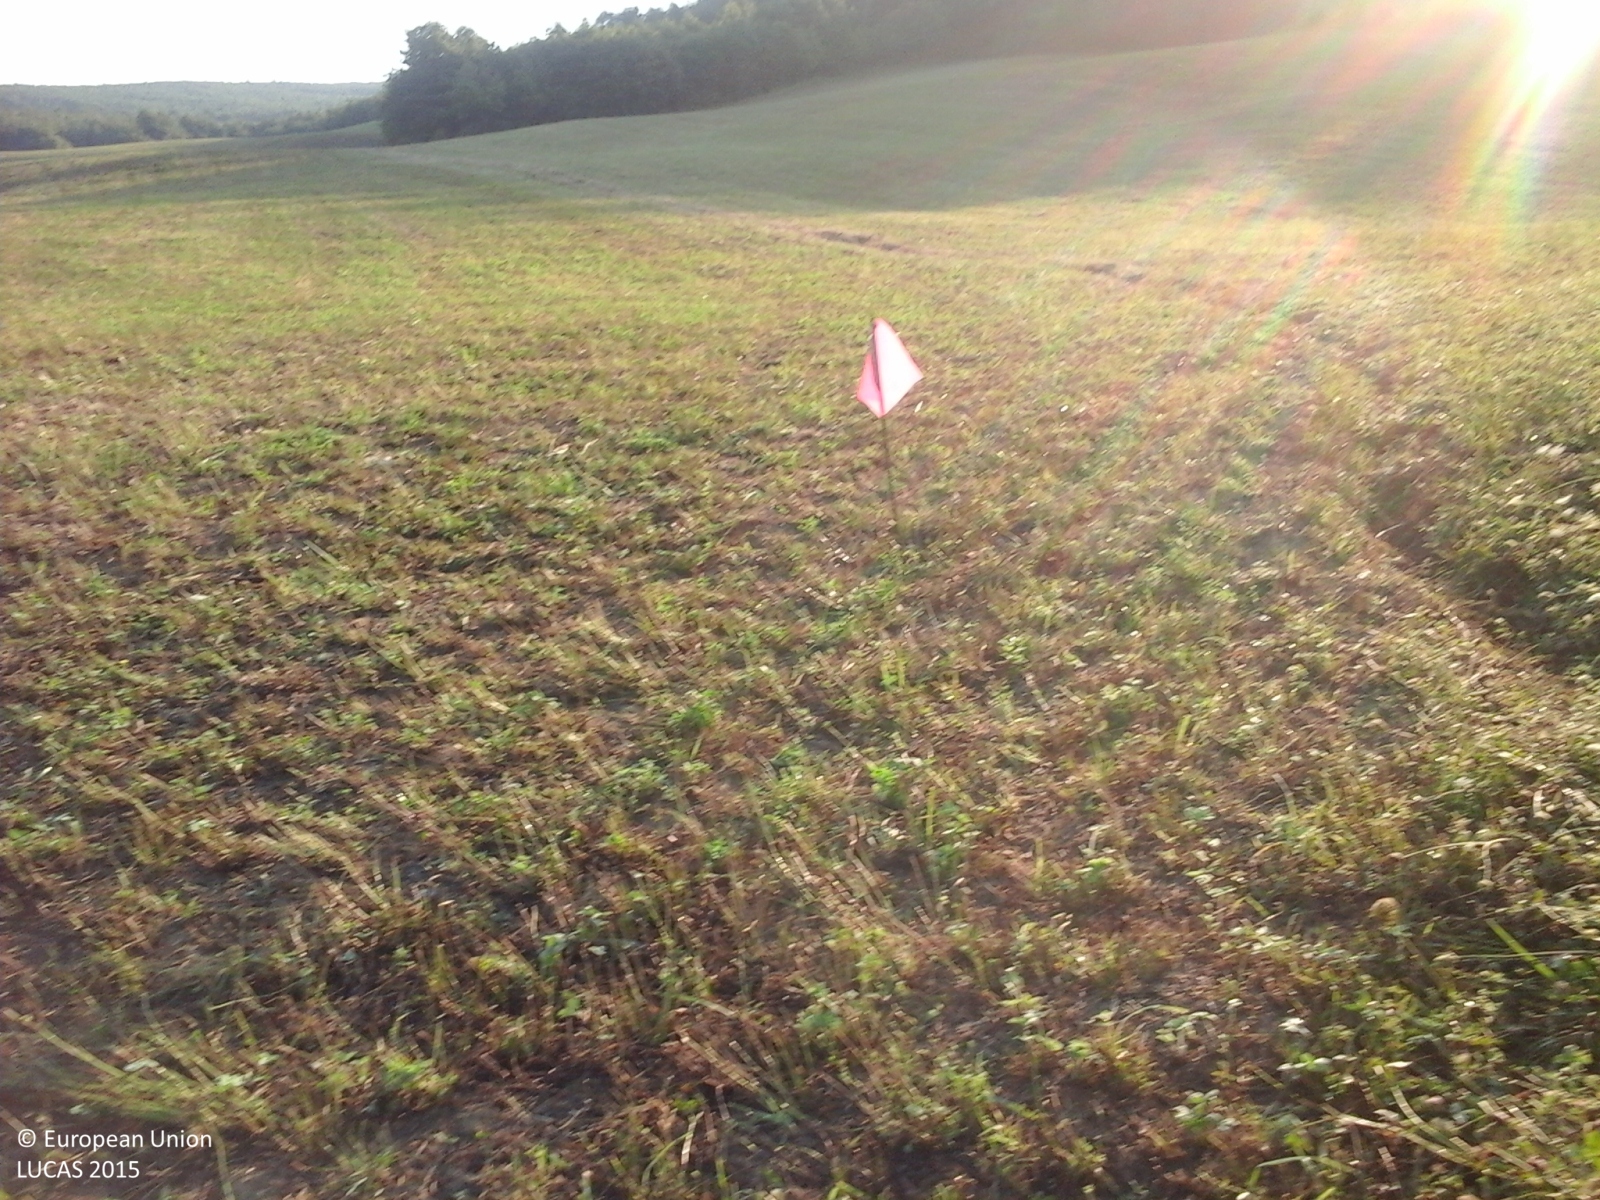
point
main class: Grassland
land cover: Grassland without tree/shrub cover
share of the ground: > 75 %
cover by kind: herbaceous plants 100 %
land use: Agriculture (excluding fallow land and kitchen gardens)
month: August
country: IT
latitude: 43.7855
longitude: 12.2188
